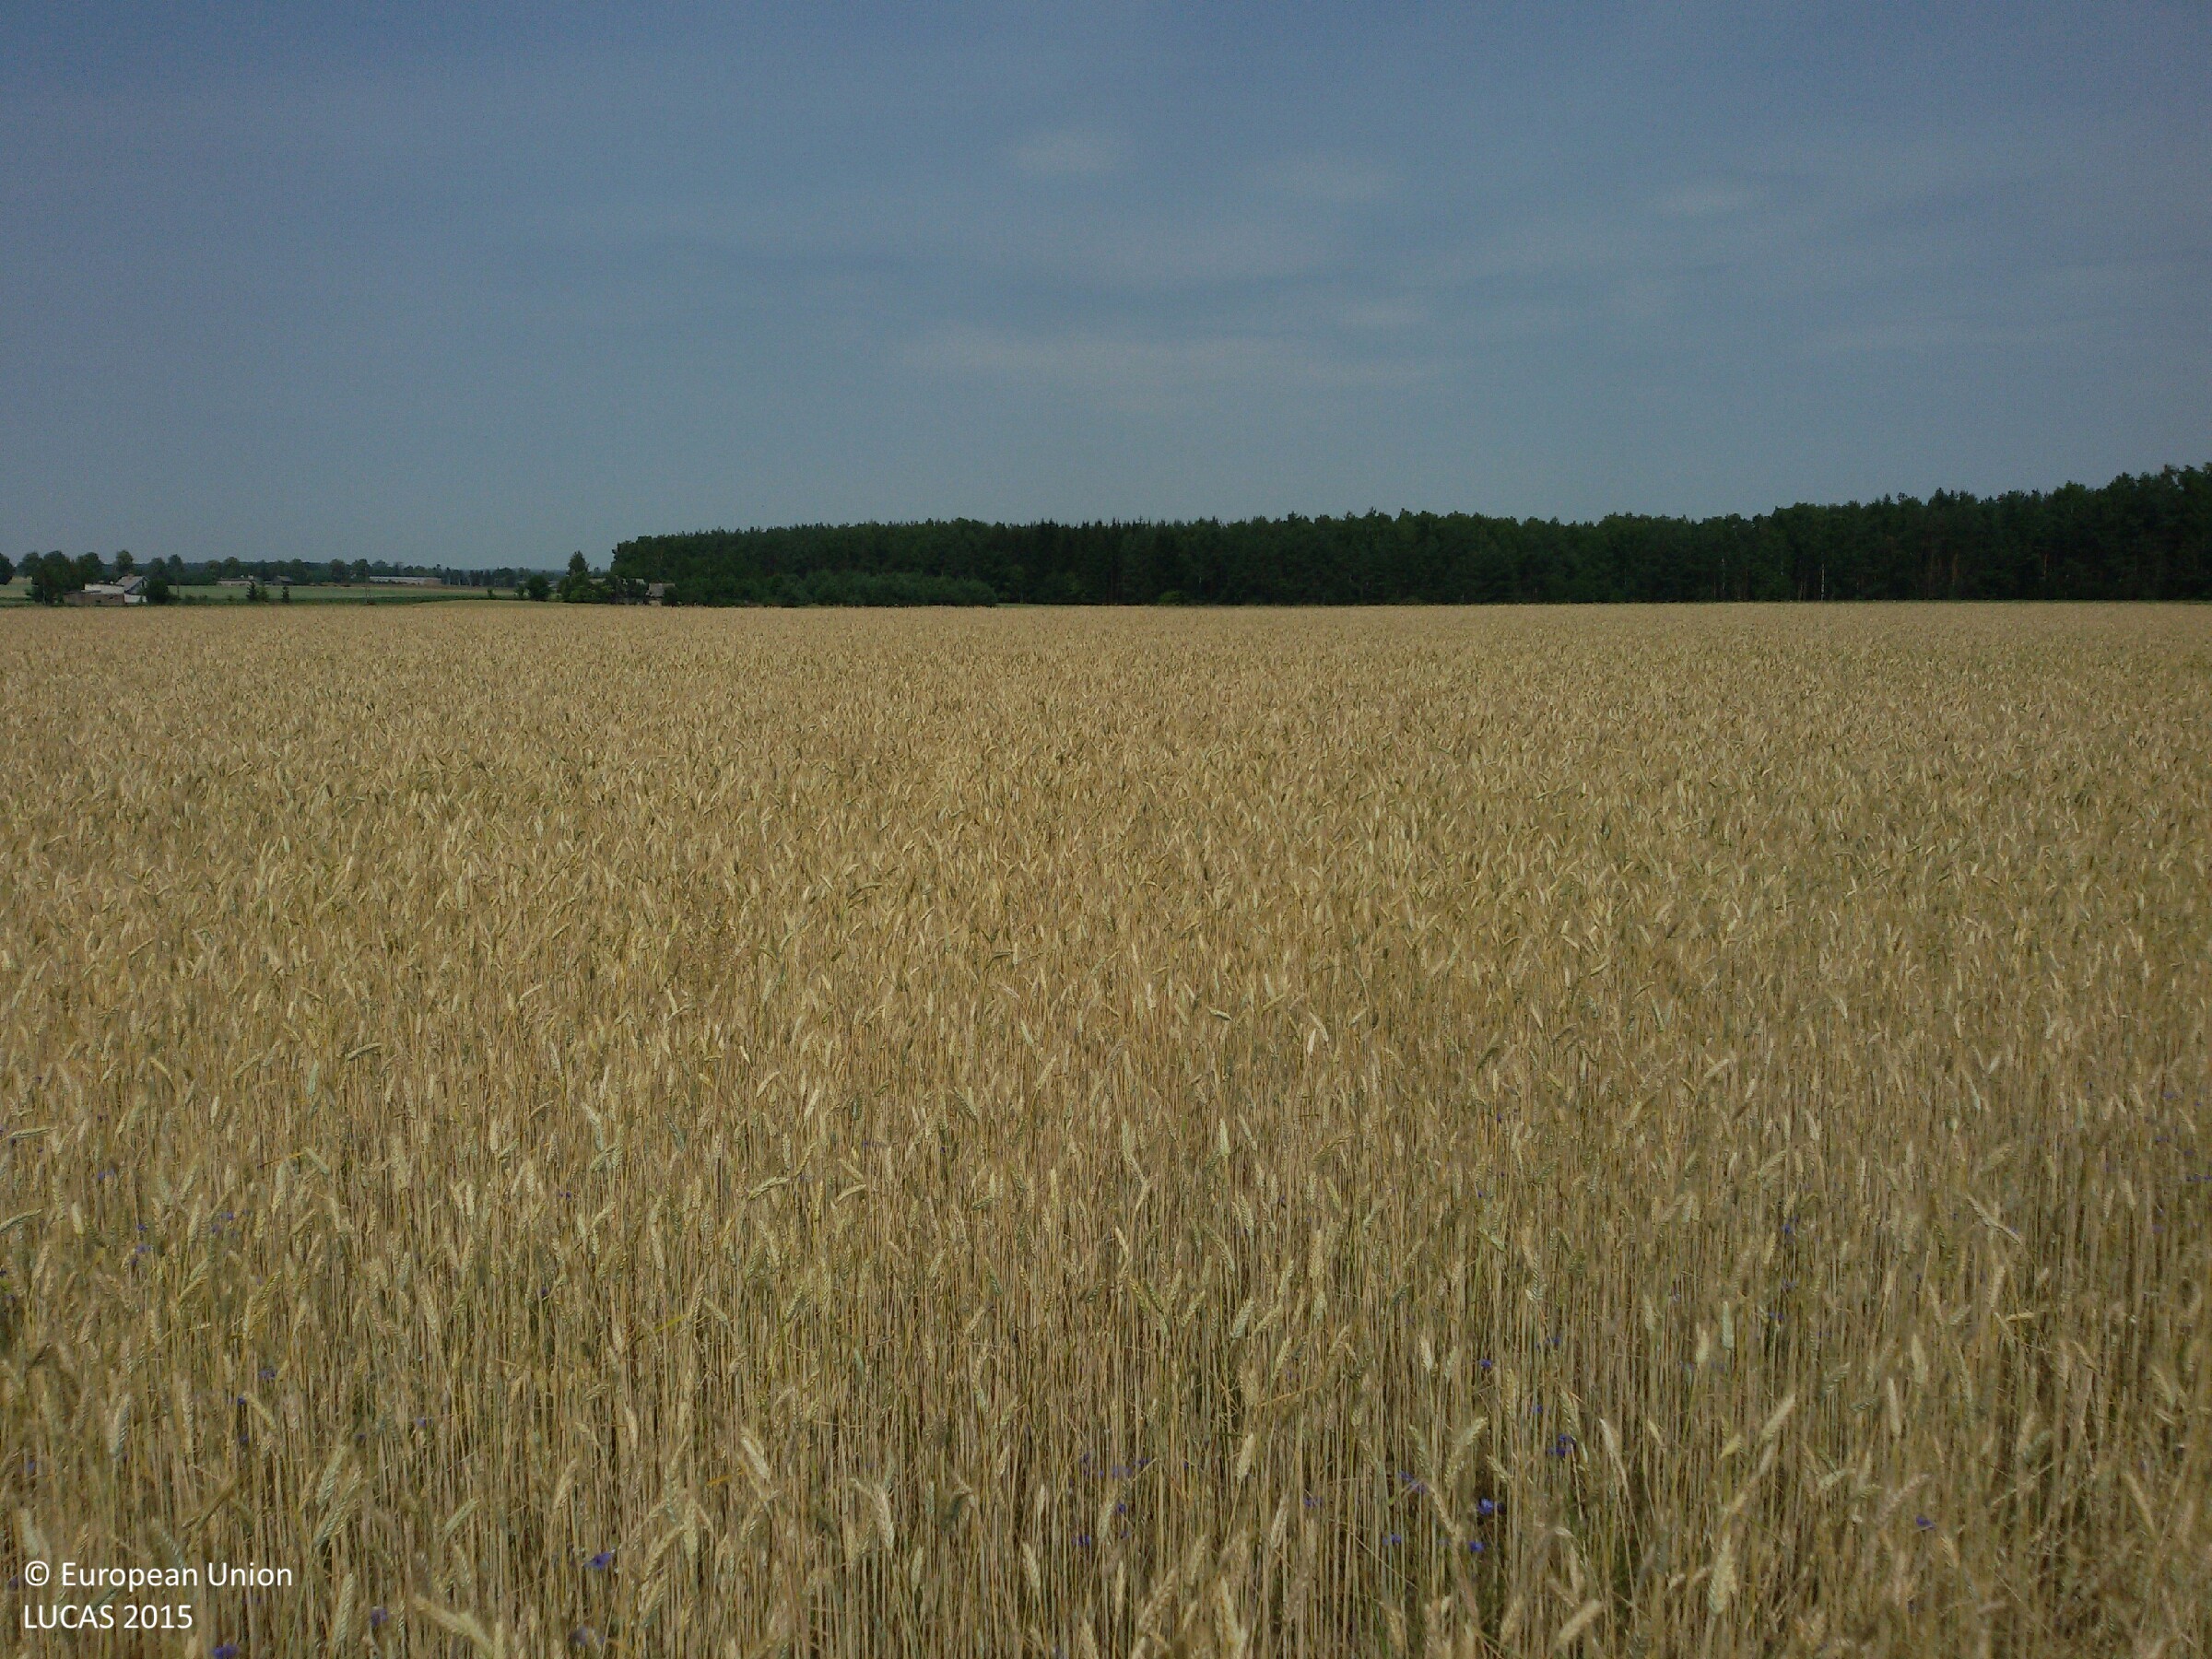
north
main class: Cropland
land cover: Common wheat
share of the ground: > 75 %
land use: Agriculture (excluding fallow land and kitchen gardens)
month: July
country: PL
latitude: 53.2869
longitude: 20.0982
